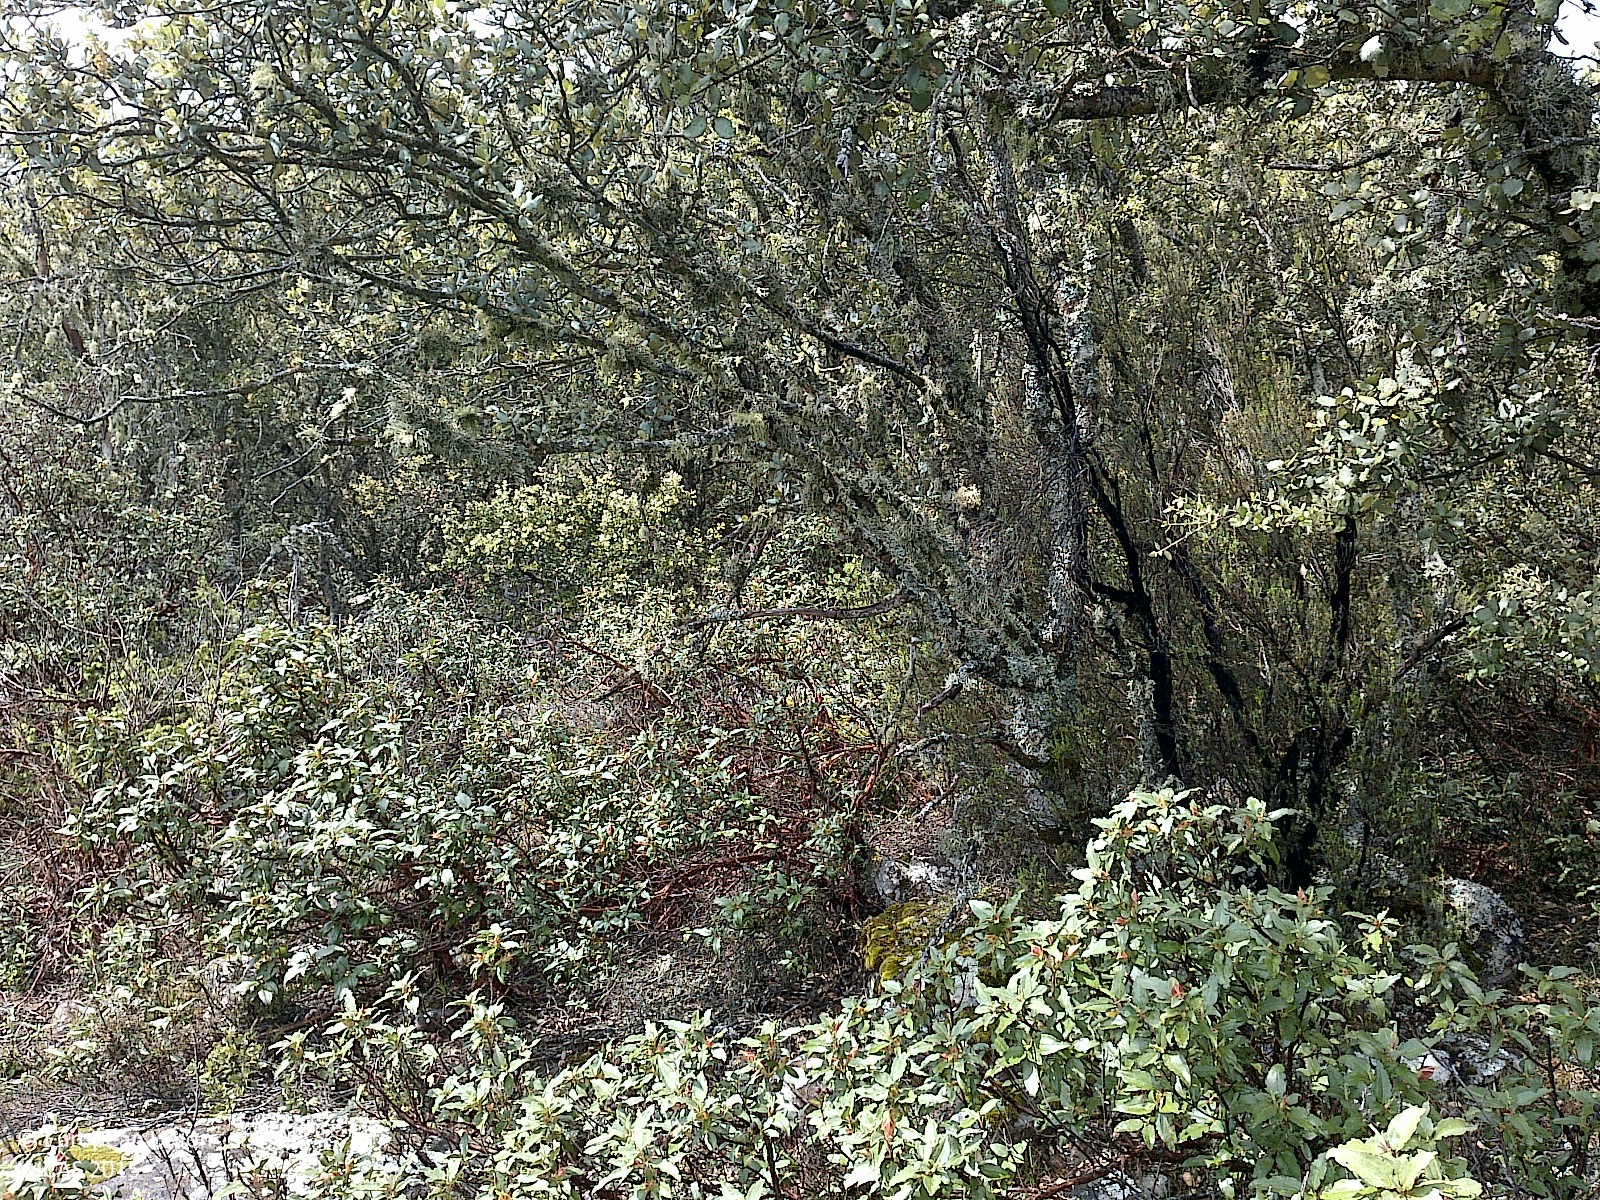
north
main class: Woodland
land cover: Broadleaved woodland
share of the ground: > 75 %
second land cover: Shrubland without tree cover
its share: 50 - 75 %
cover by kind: broadleaved forest trees 75 %, shrubs 15 %, herbaceous plants 5 %, consolidated bare surface 5 %
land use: Forestry
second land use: Agriculture (excluding fallow land and kitchen gardens)
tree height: < 5 m
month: May
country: ES
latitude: 41.8156
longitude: -2.2548
